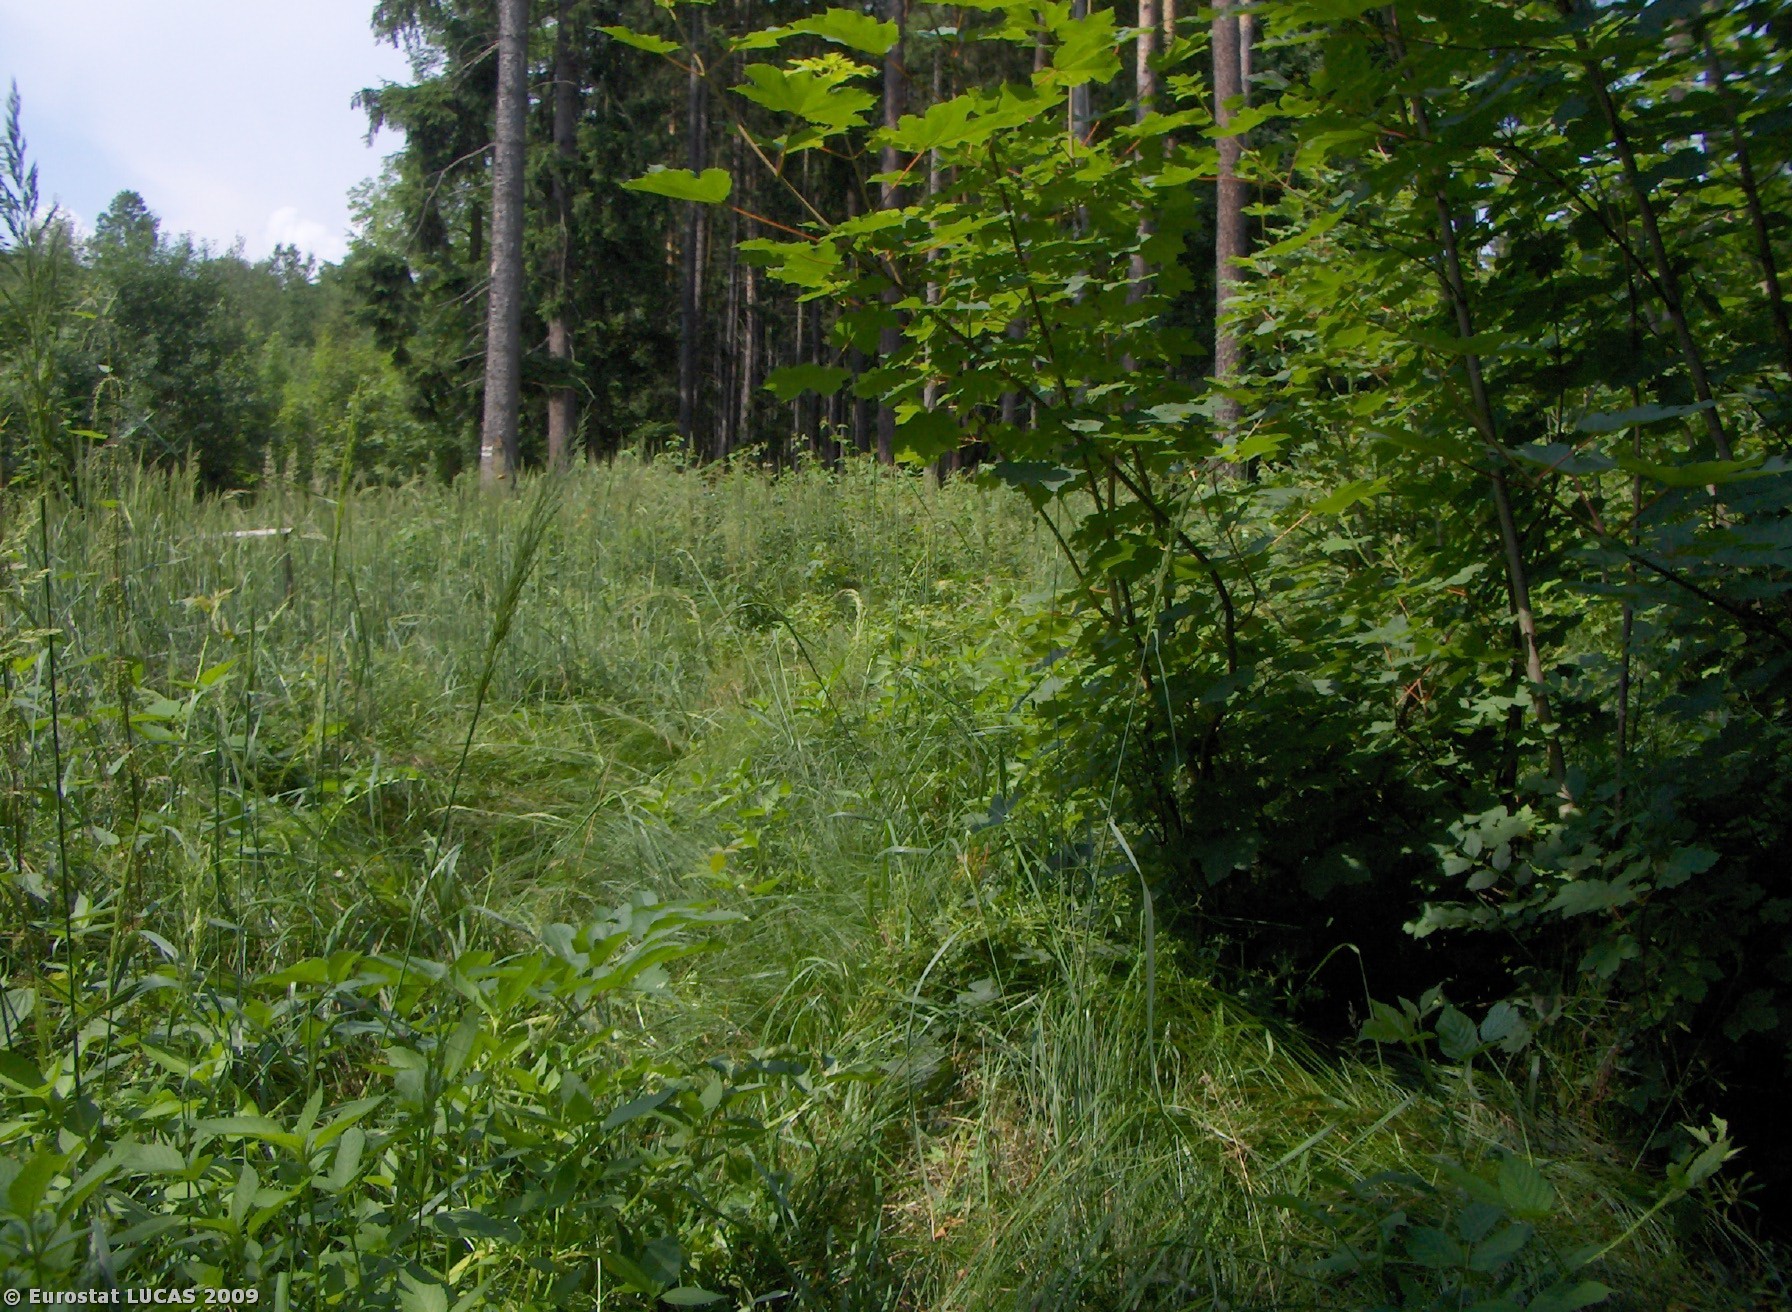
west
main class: Woodland
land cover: Broadleaved woodland
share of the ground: > 75 %
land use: Forestry
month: July
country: CZ
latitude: 49.5457
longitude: 13.1925
